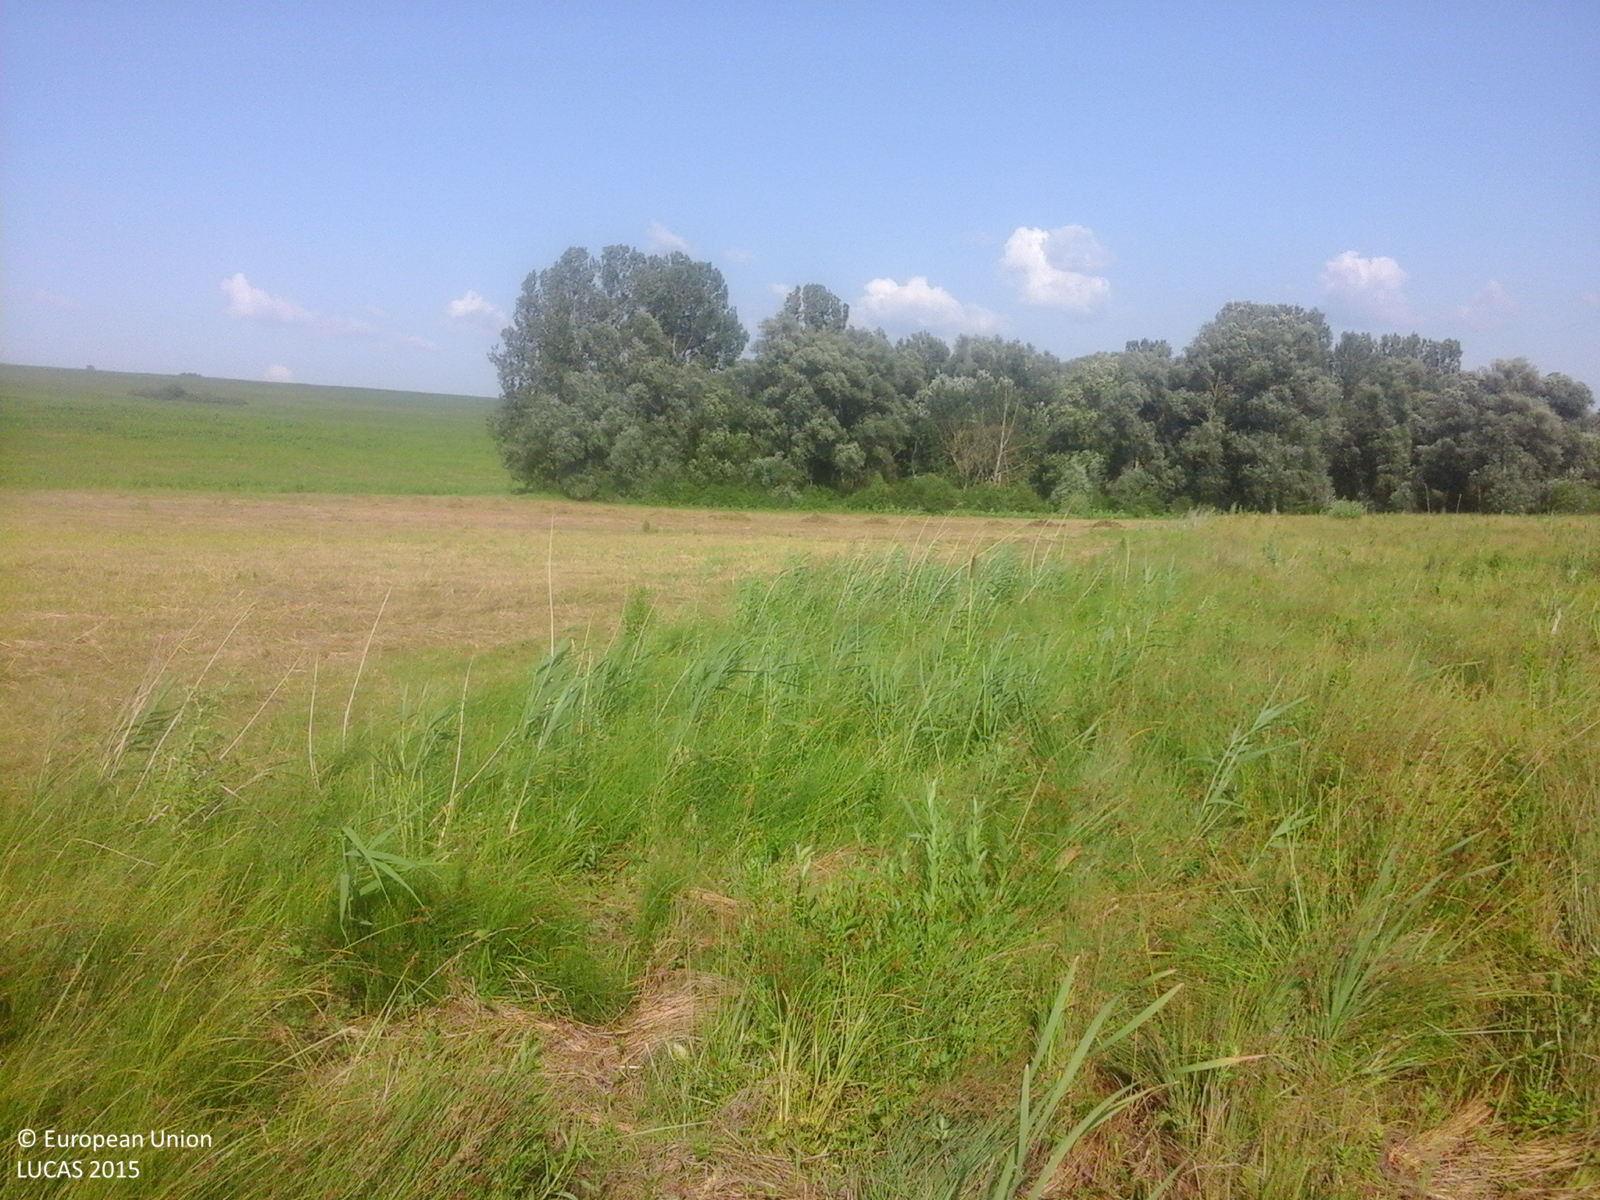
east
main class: Grassland
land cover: Grassland without tree/shrub cover
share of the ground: > 75 %
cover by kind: herbaceous plants 95 %, shrubs 5 %
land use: Agriculture (excluding fallow land and kitchen gardens)
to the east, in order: Grassland without tree/shrub cover; Broadleaved woodland; Tracks; Broadleaved woodland
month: June
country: RO
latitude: 46.5874
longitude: 27.7244
